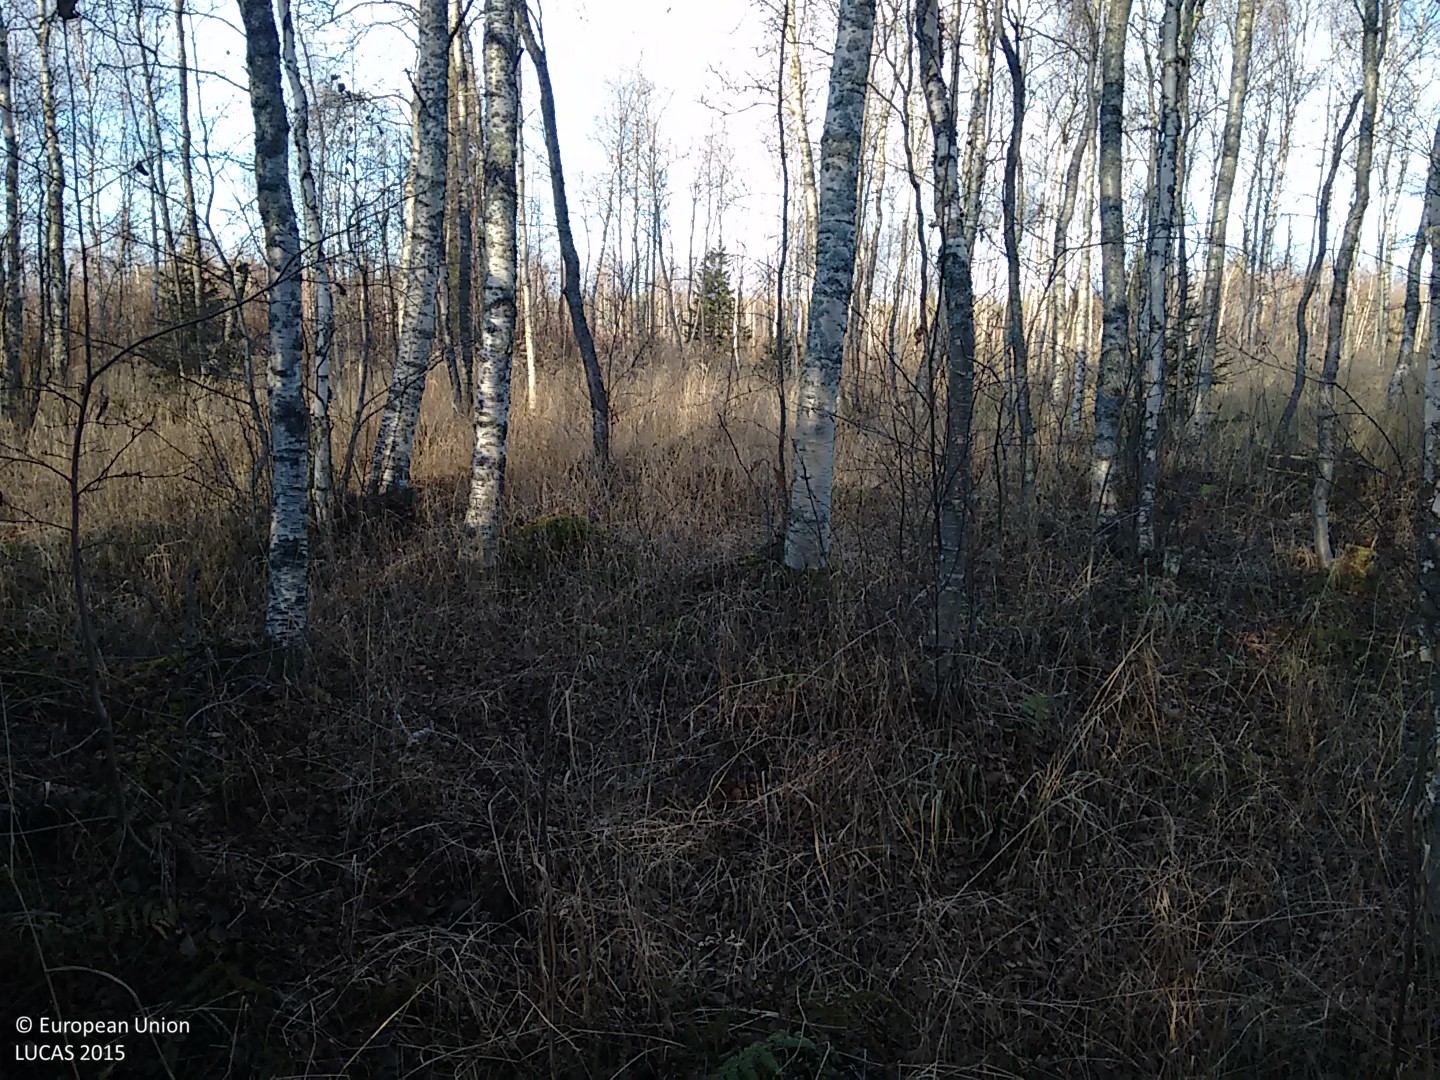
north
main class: Woodland
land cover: Spruce dominated mixed woodland
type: boreal forest
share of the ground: > 75 %
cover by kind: coniferous forest trees 45 %, broadleaved forest trees 40 %, herbaceous plants 10 %, shrubs 5 %
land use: Forestry
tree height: > 5 m
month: October
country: FI
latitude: 64.7656
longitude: 24.6375
